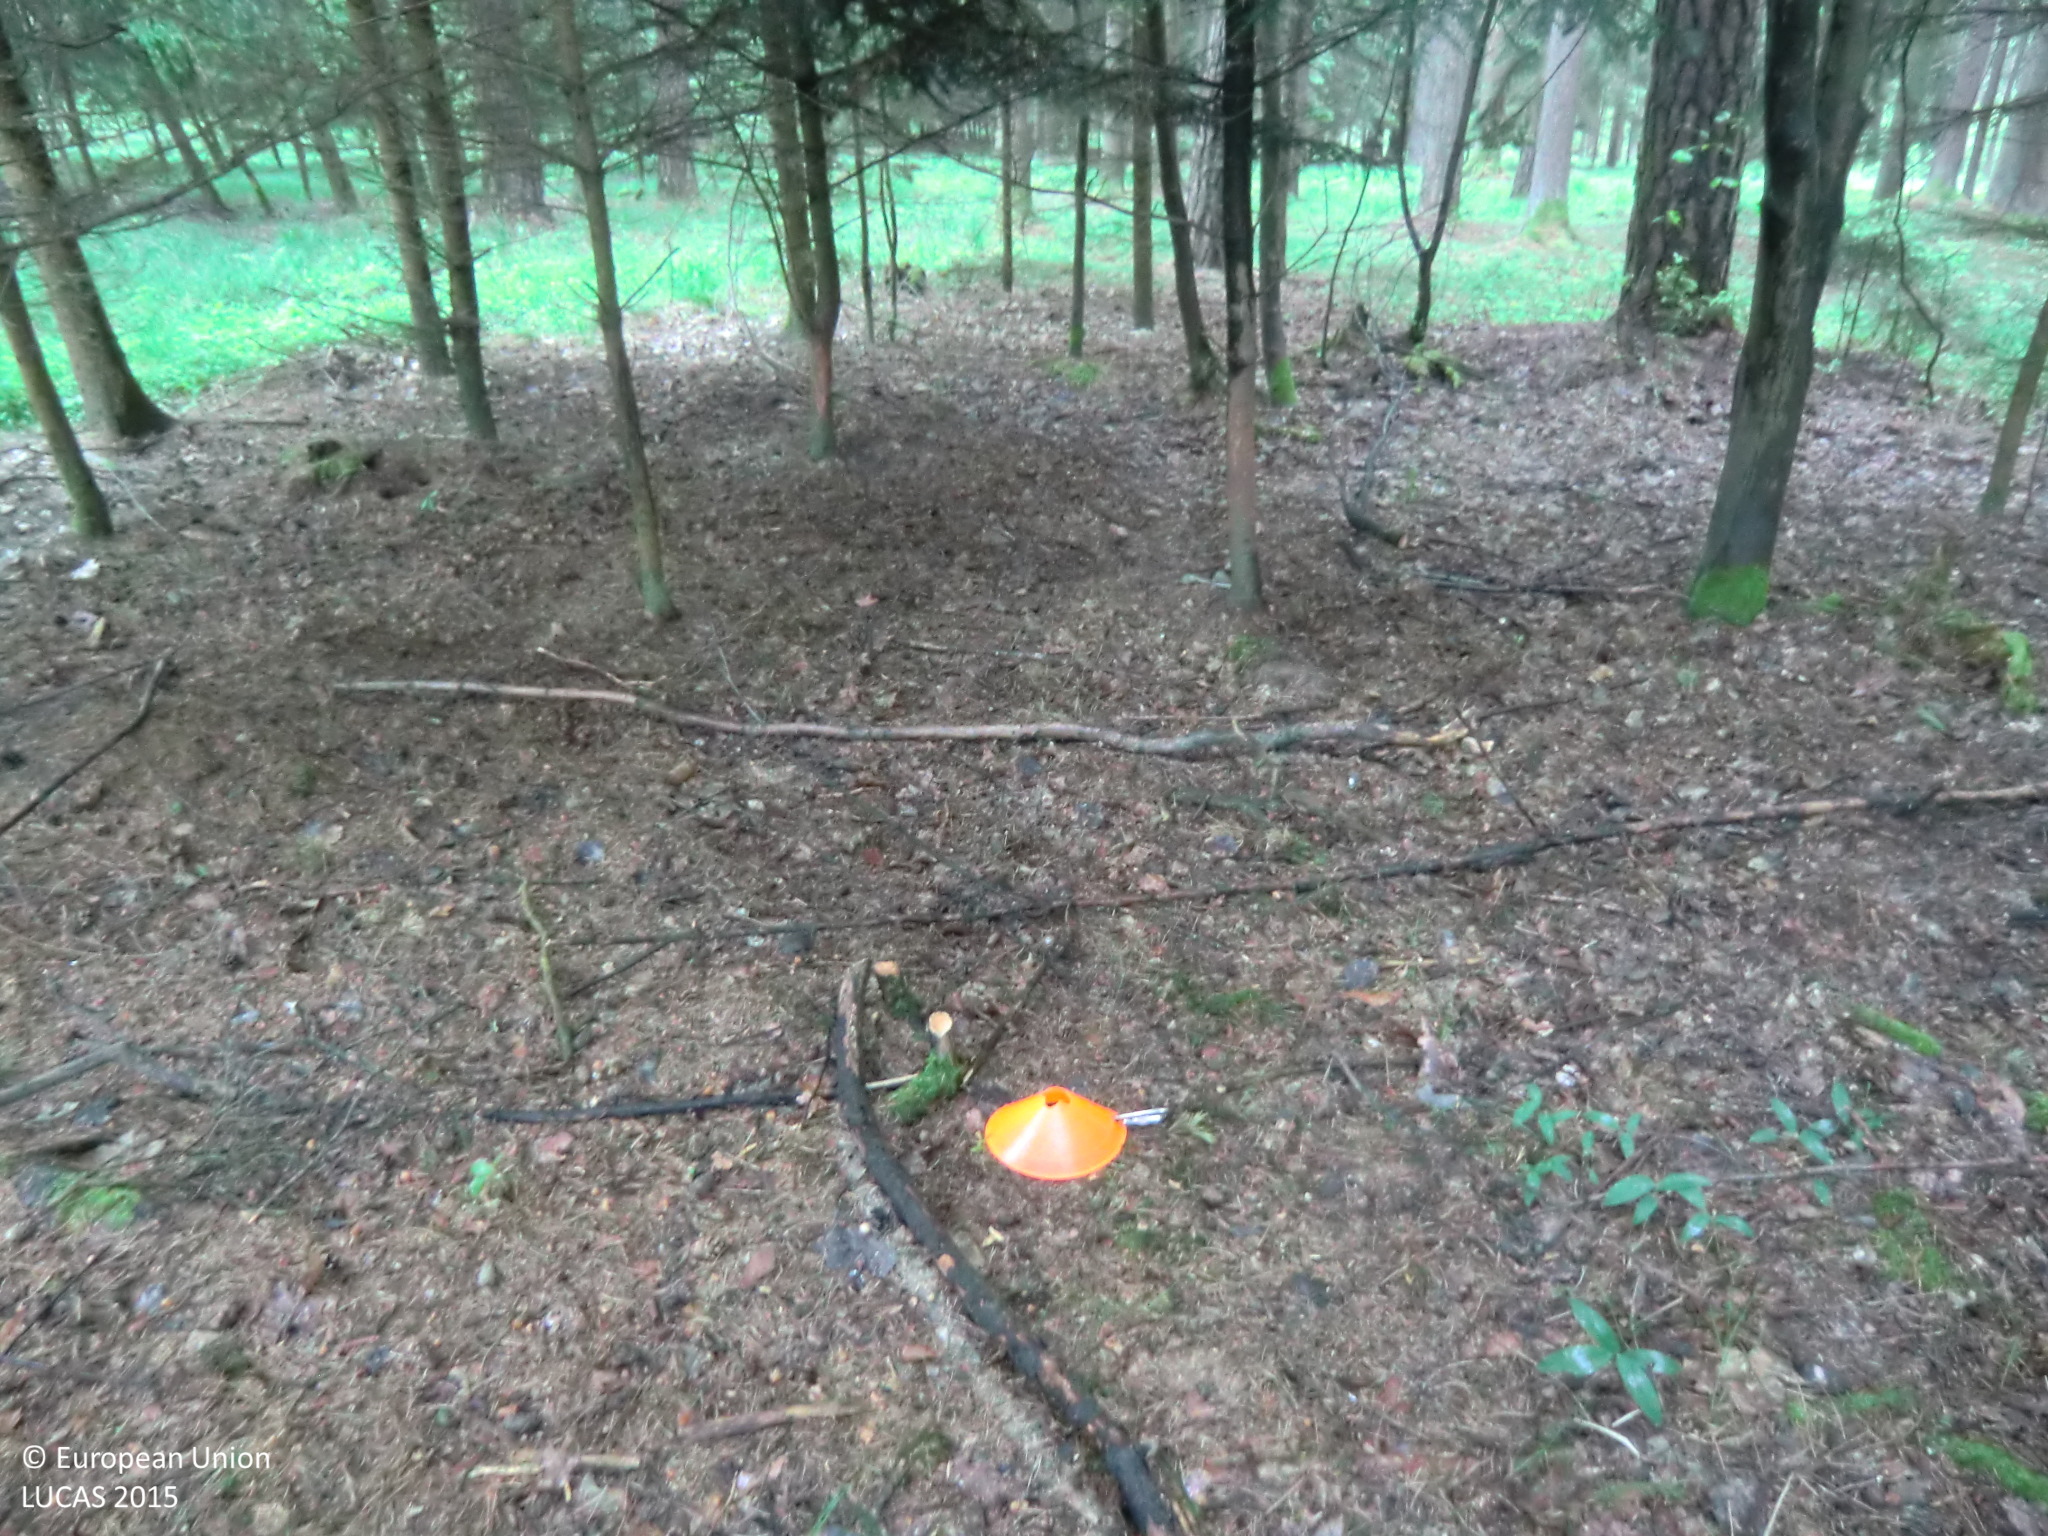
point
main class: Woodland
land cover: Pine dominated mixed woodland
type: hemiboreal forest and nemoral coniferous forest and mixed broadleaved-coniferous forest
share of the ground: > 75 %
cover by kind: coniferous forest trees 40 %, broadleaved forest trees 40 %, shrubs 10 %, herbaceous plants 10 %
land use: Forestry
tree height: > 5 m
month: May
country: AT
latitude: 48.3684
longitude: 14.4415
